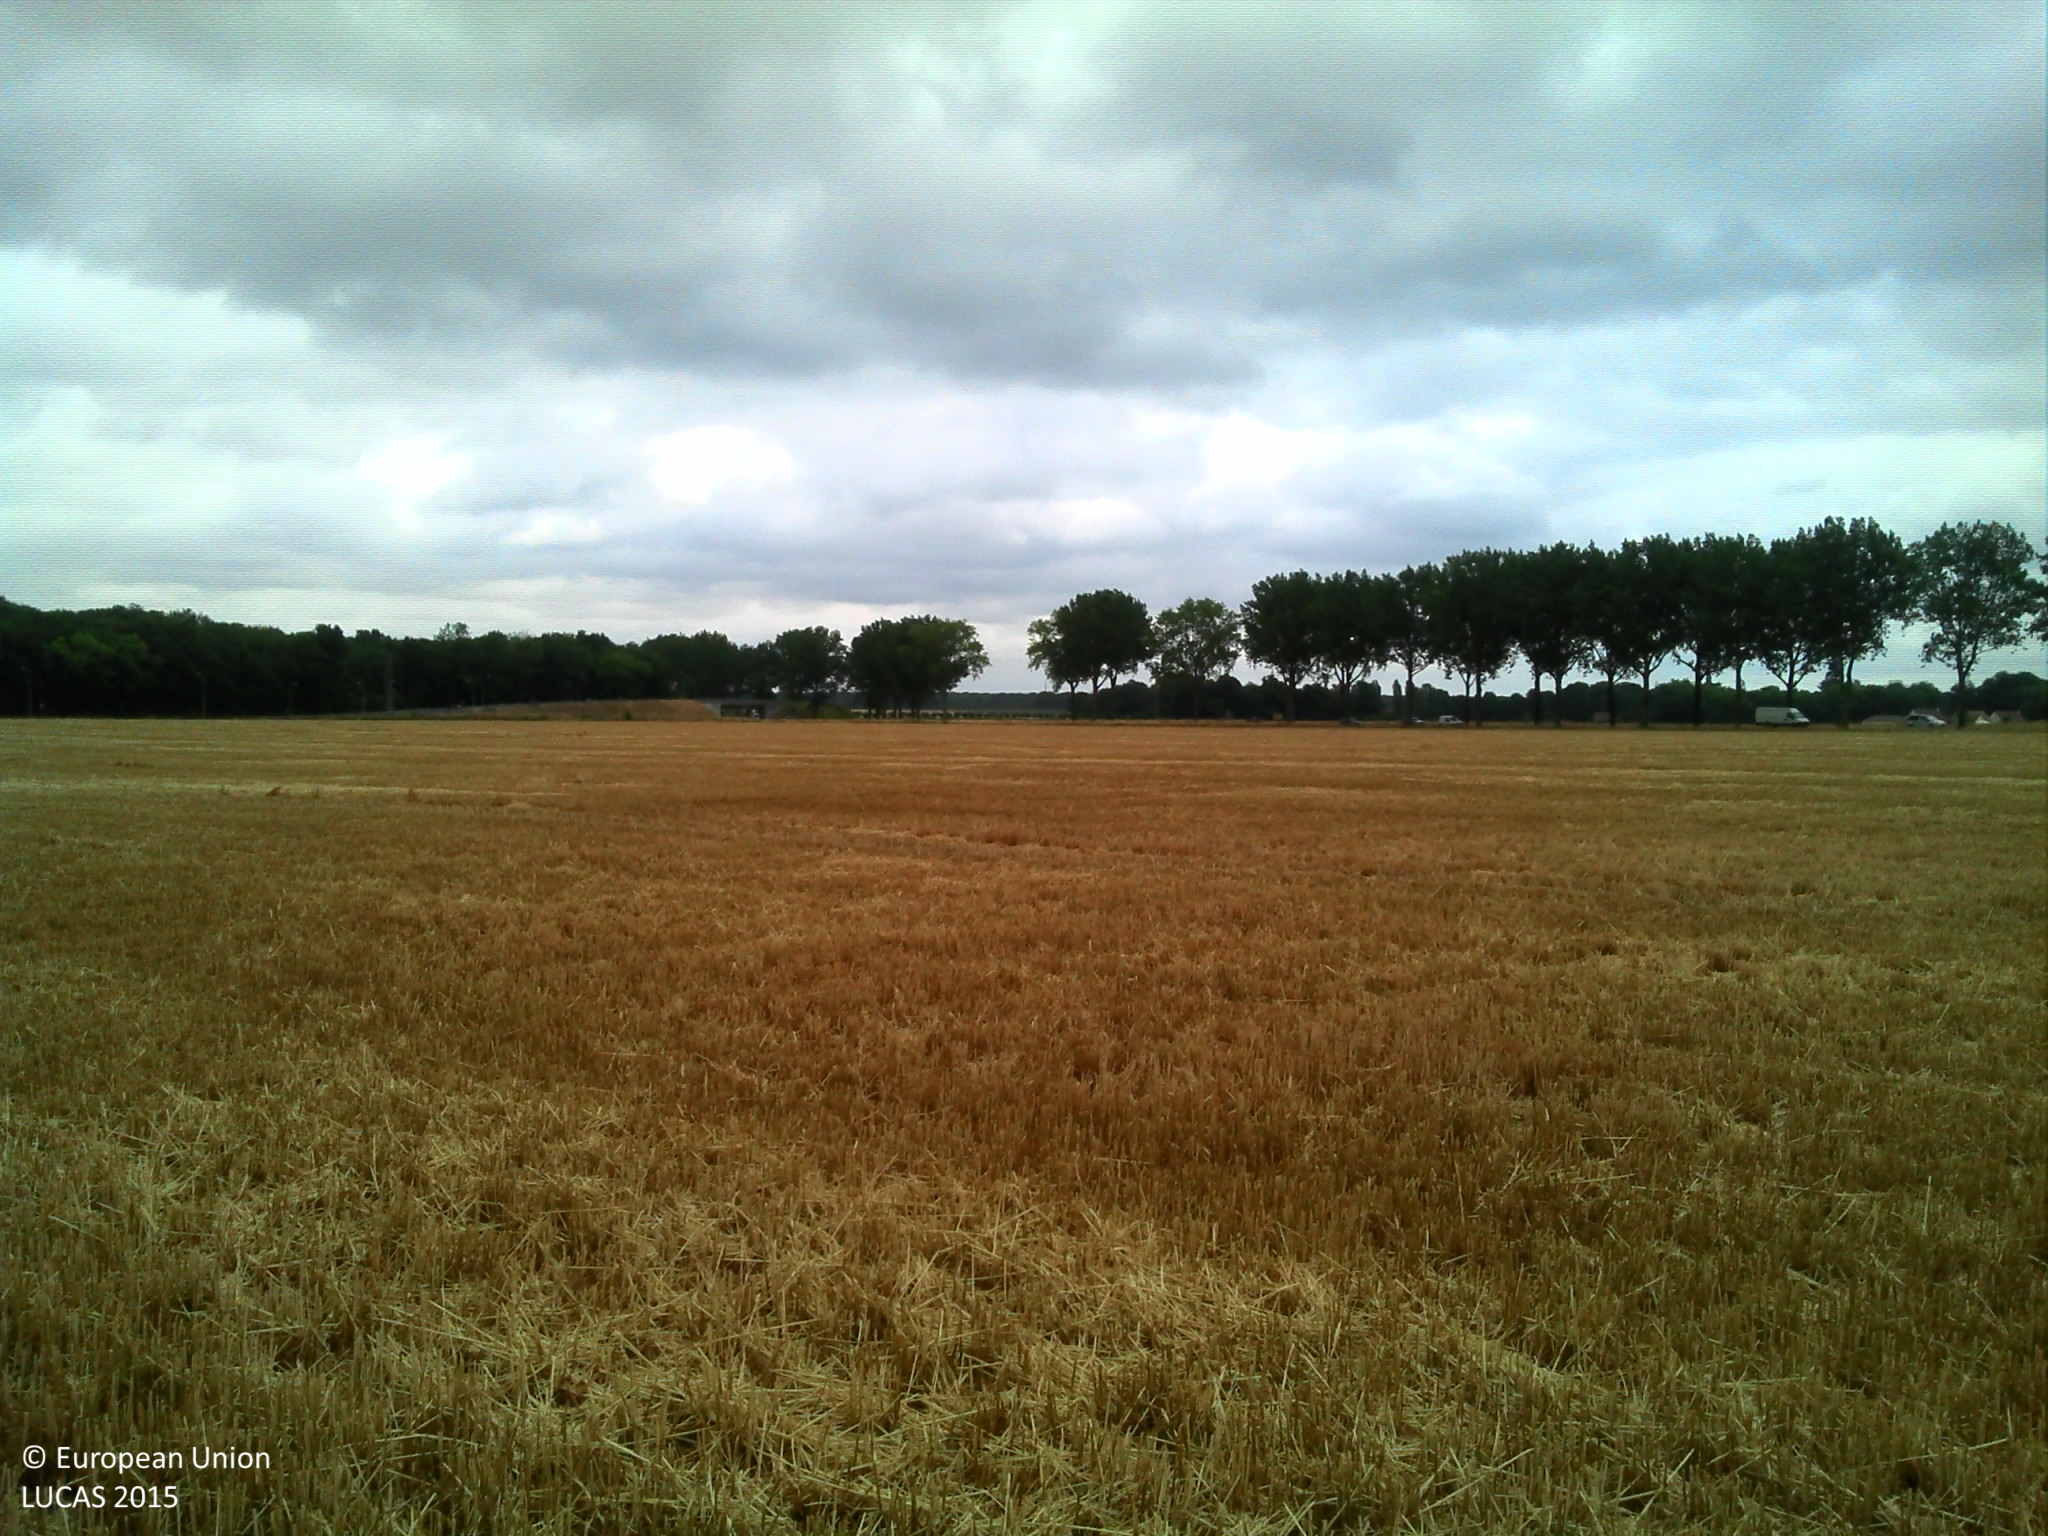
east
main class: Cropland
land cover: Common wheat
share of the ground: > 75 %
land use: Agriculture (excluding fallow land and kitchen gardens)
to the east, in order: Common wheat
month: July
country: FR
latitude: 48.4978
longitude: 2.5872
